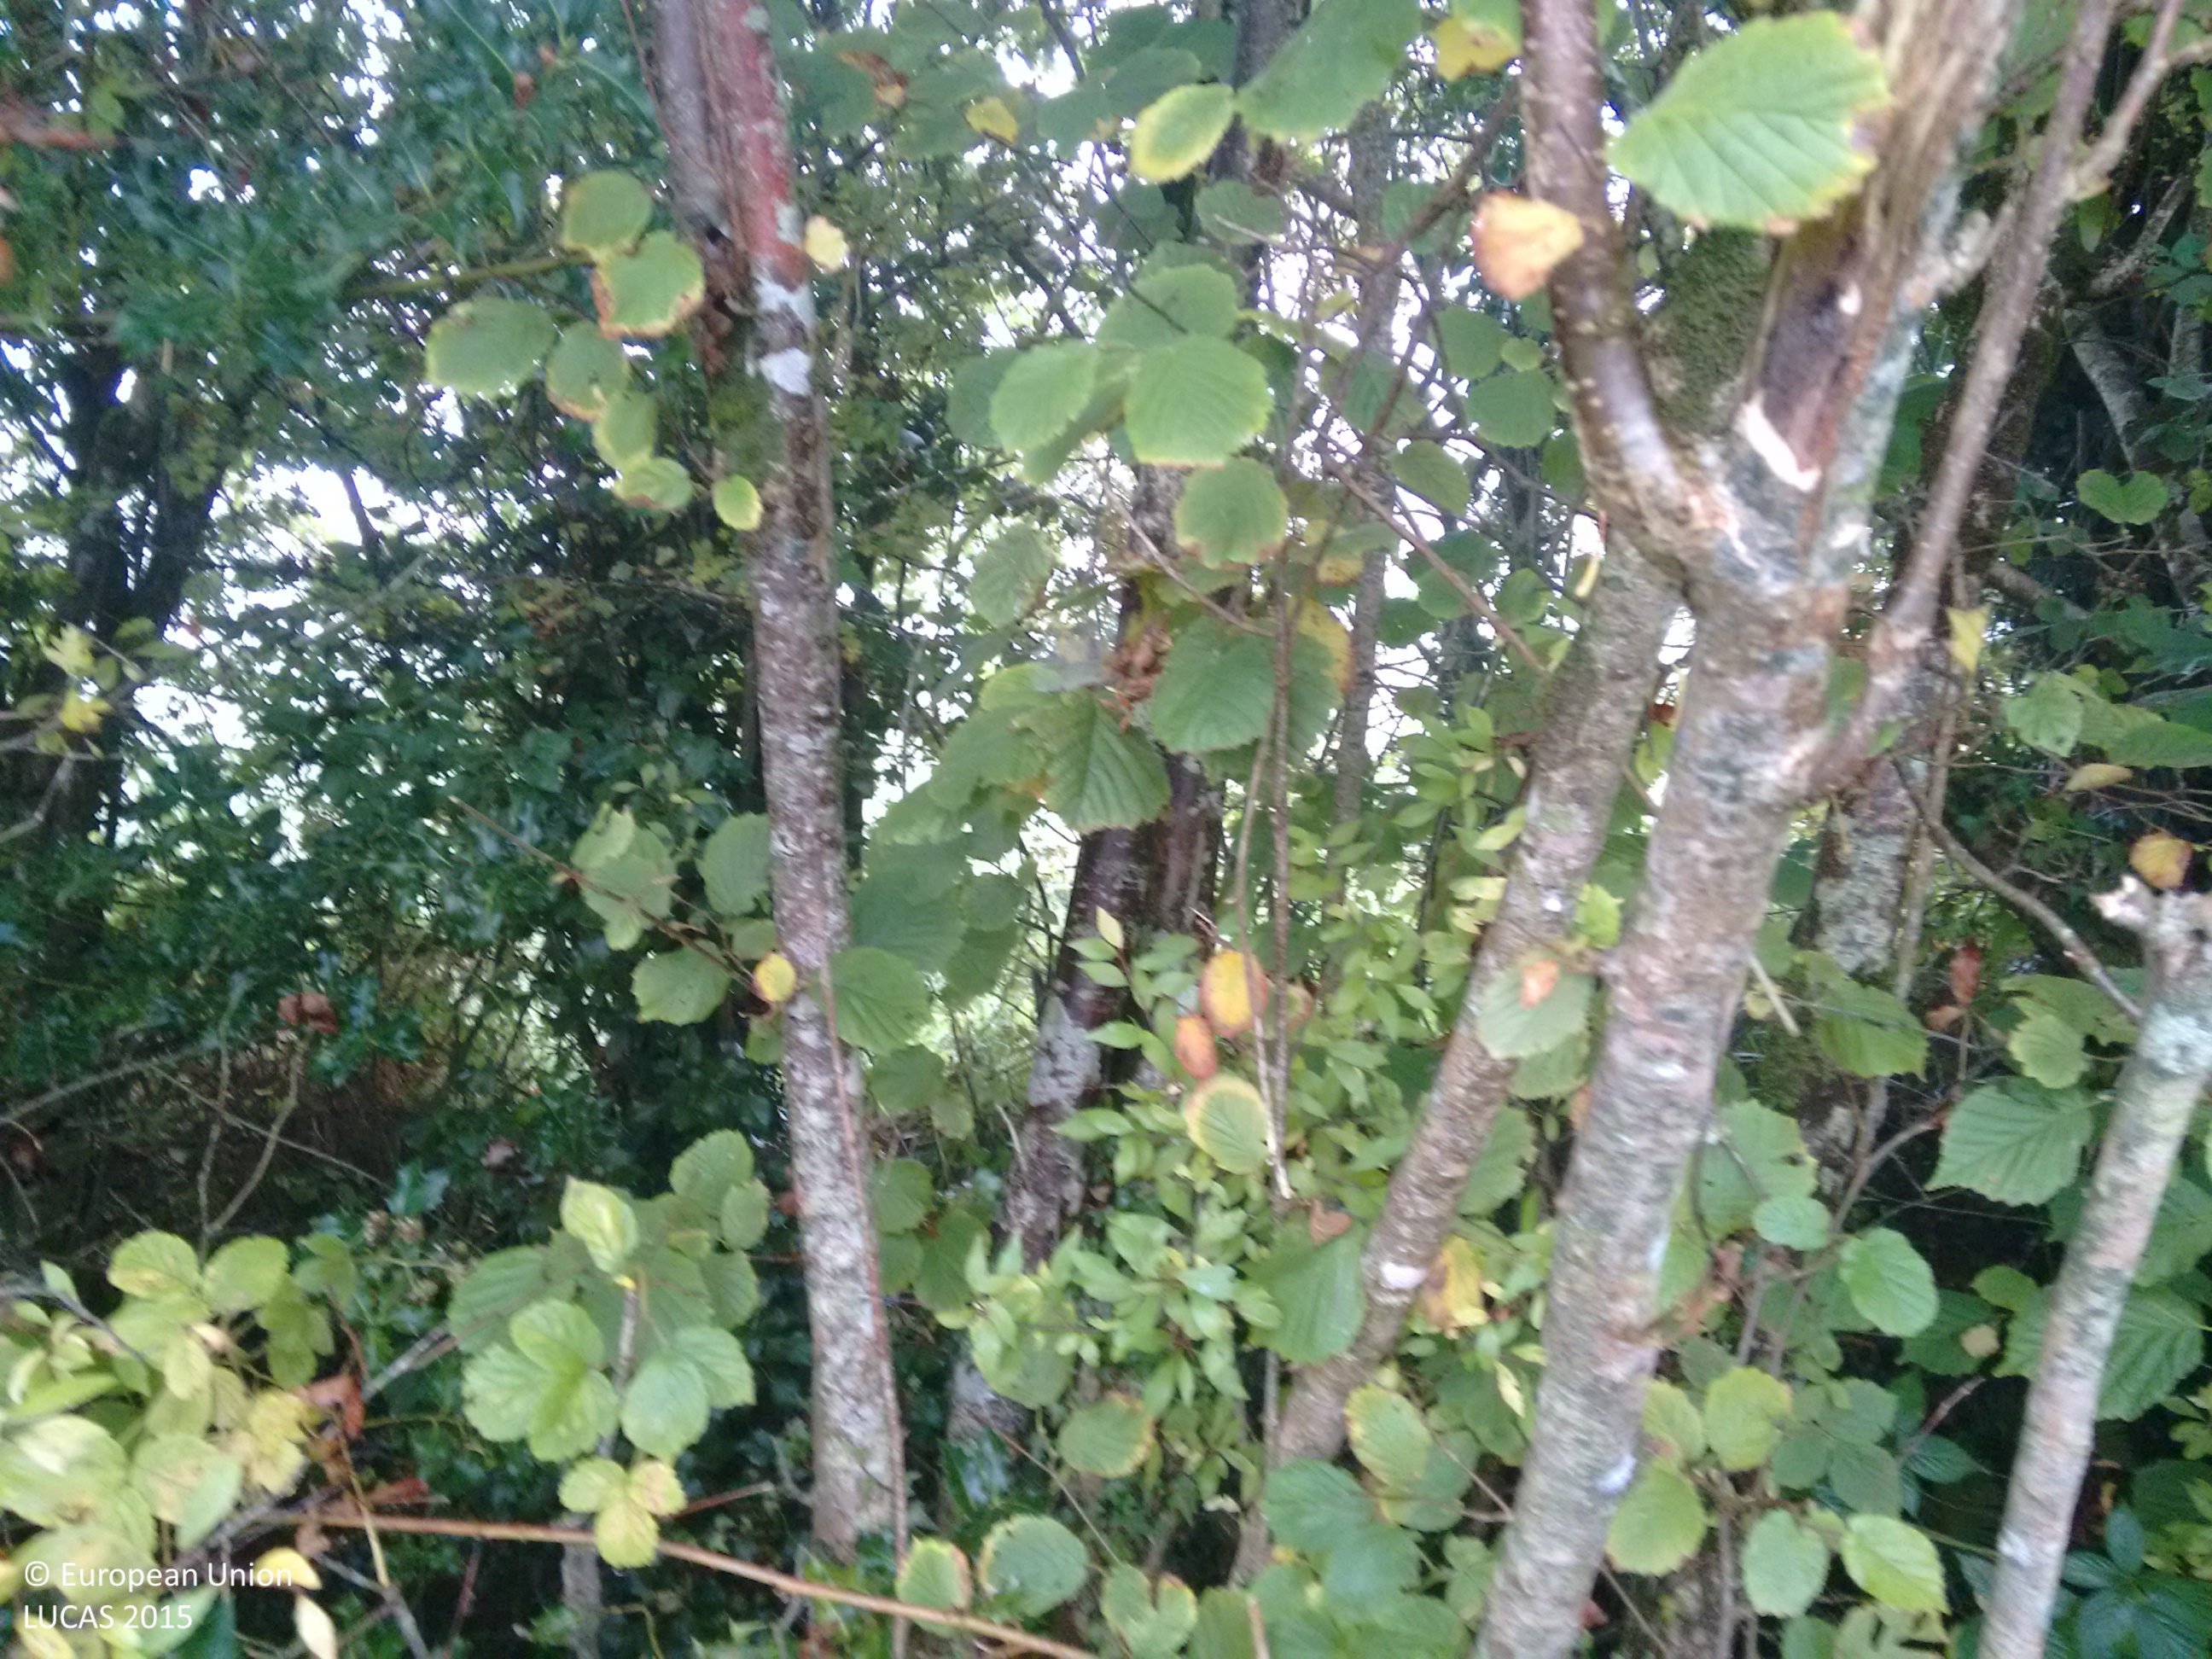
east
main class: Grassland
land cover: Grassland without tree/shrub cover
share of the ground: > 75 %
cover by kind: herbaceous plants 100 %
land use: Agriculture (excluding fallow land and kitchen gardens)
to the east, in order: Grassland without tree/shrub cover; Abandoned hedges; Grass margins; Abandoned hedges; Artificial constructions in urban areas; Grassland without tree/shrub cover; Abandoned hedges; Grassland without tree/shrub cover
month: October
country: GB
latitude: 54.3268
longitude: -7.7396
